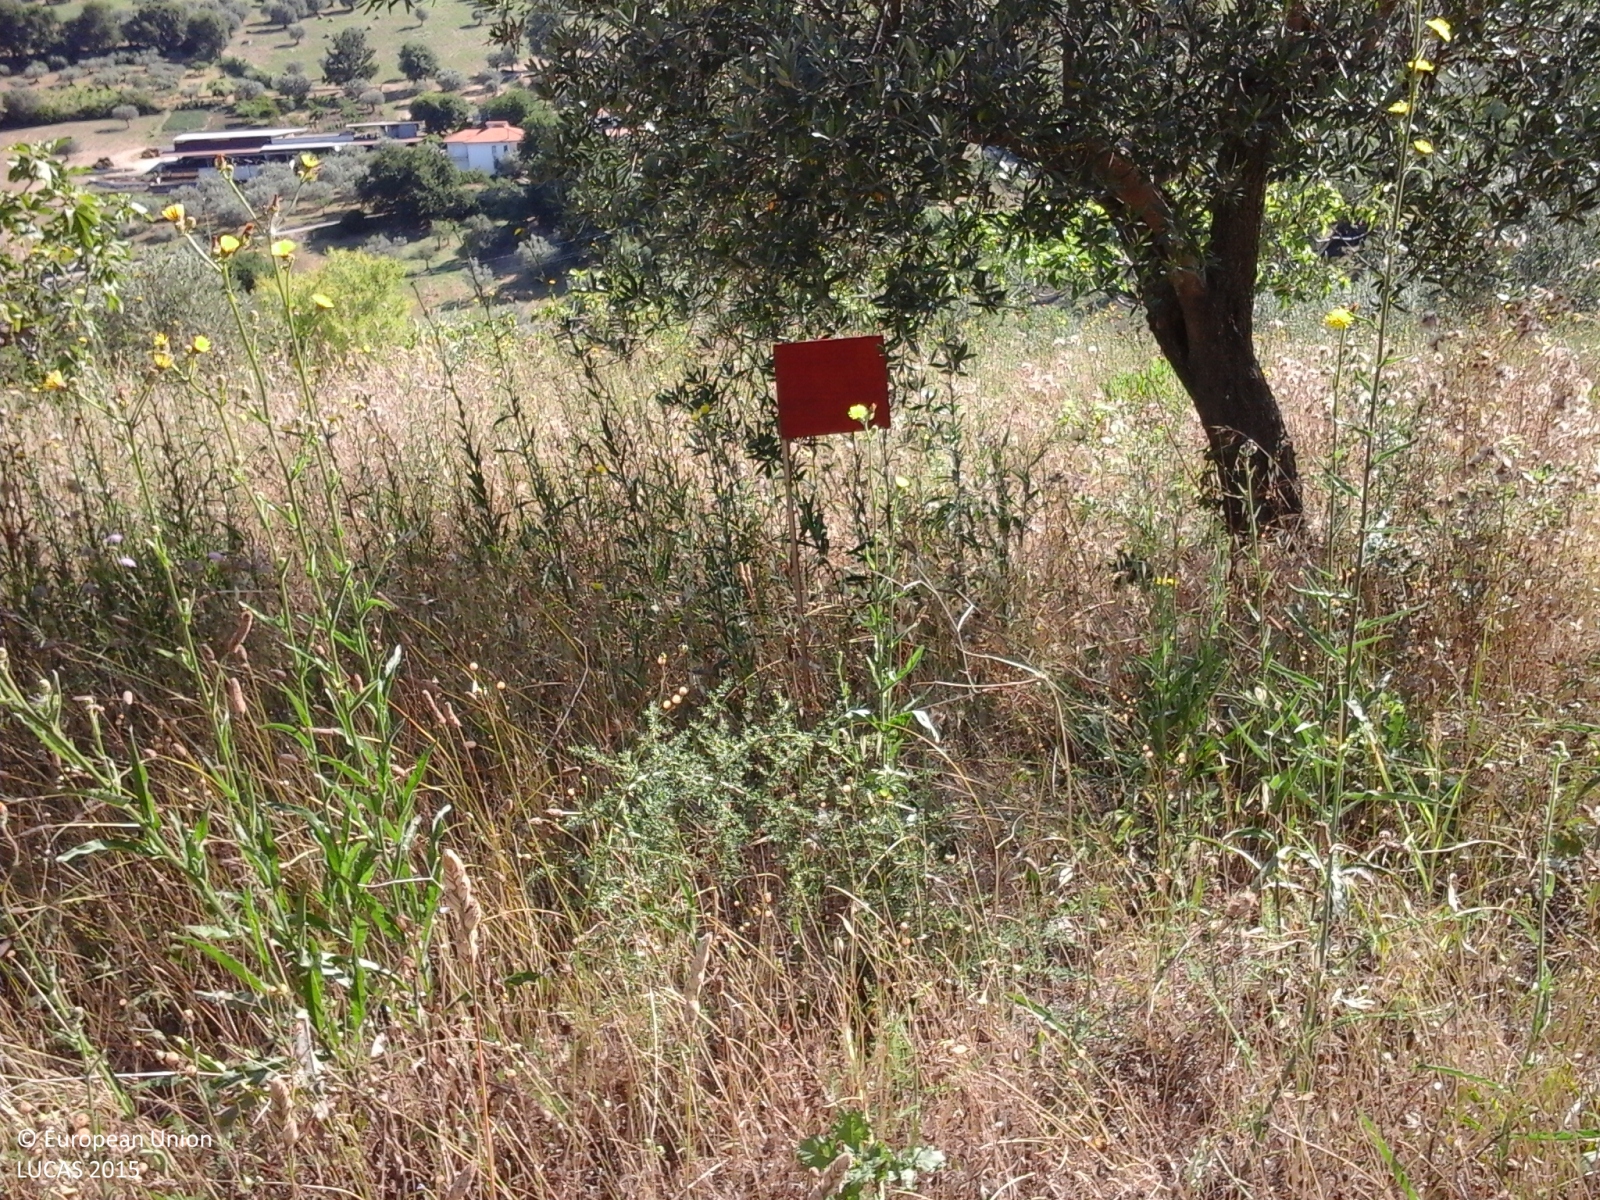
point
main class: Cropland
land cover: Olive groves
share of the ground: 25 - 50 %
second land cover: Other fruit trees and berries
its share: 25 - 50 %
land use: Agriculture (excluding fallow land and kitchen gardens)
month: June
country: IT
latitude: 40.3884
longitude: 15.1024
